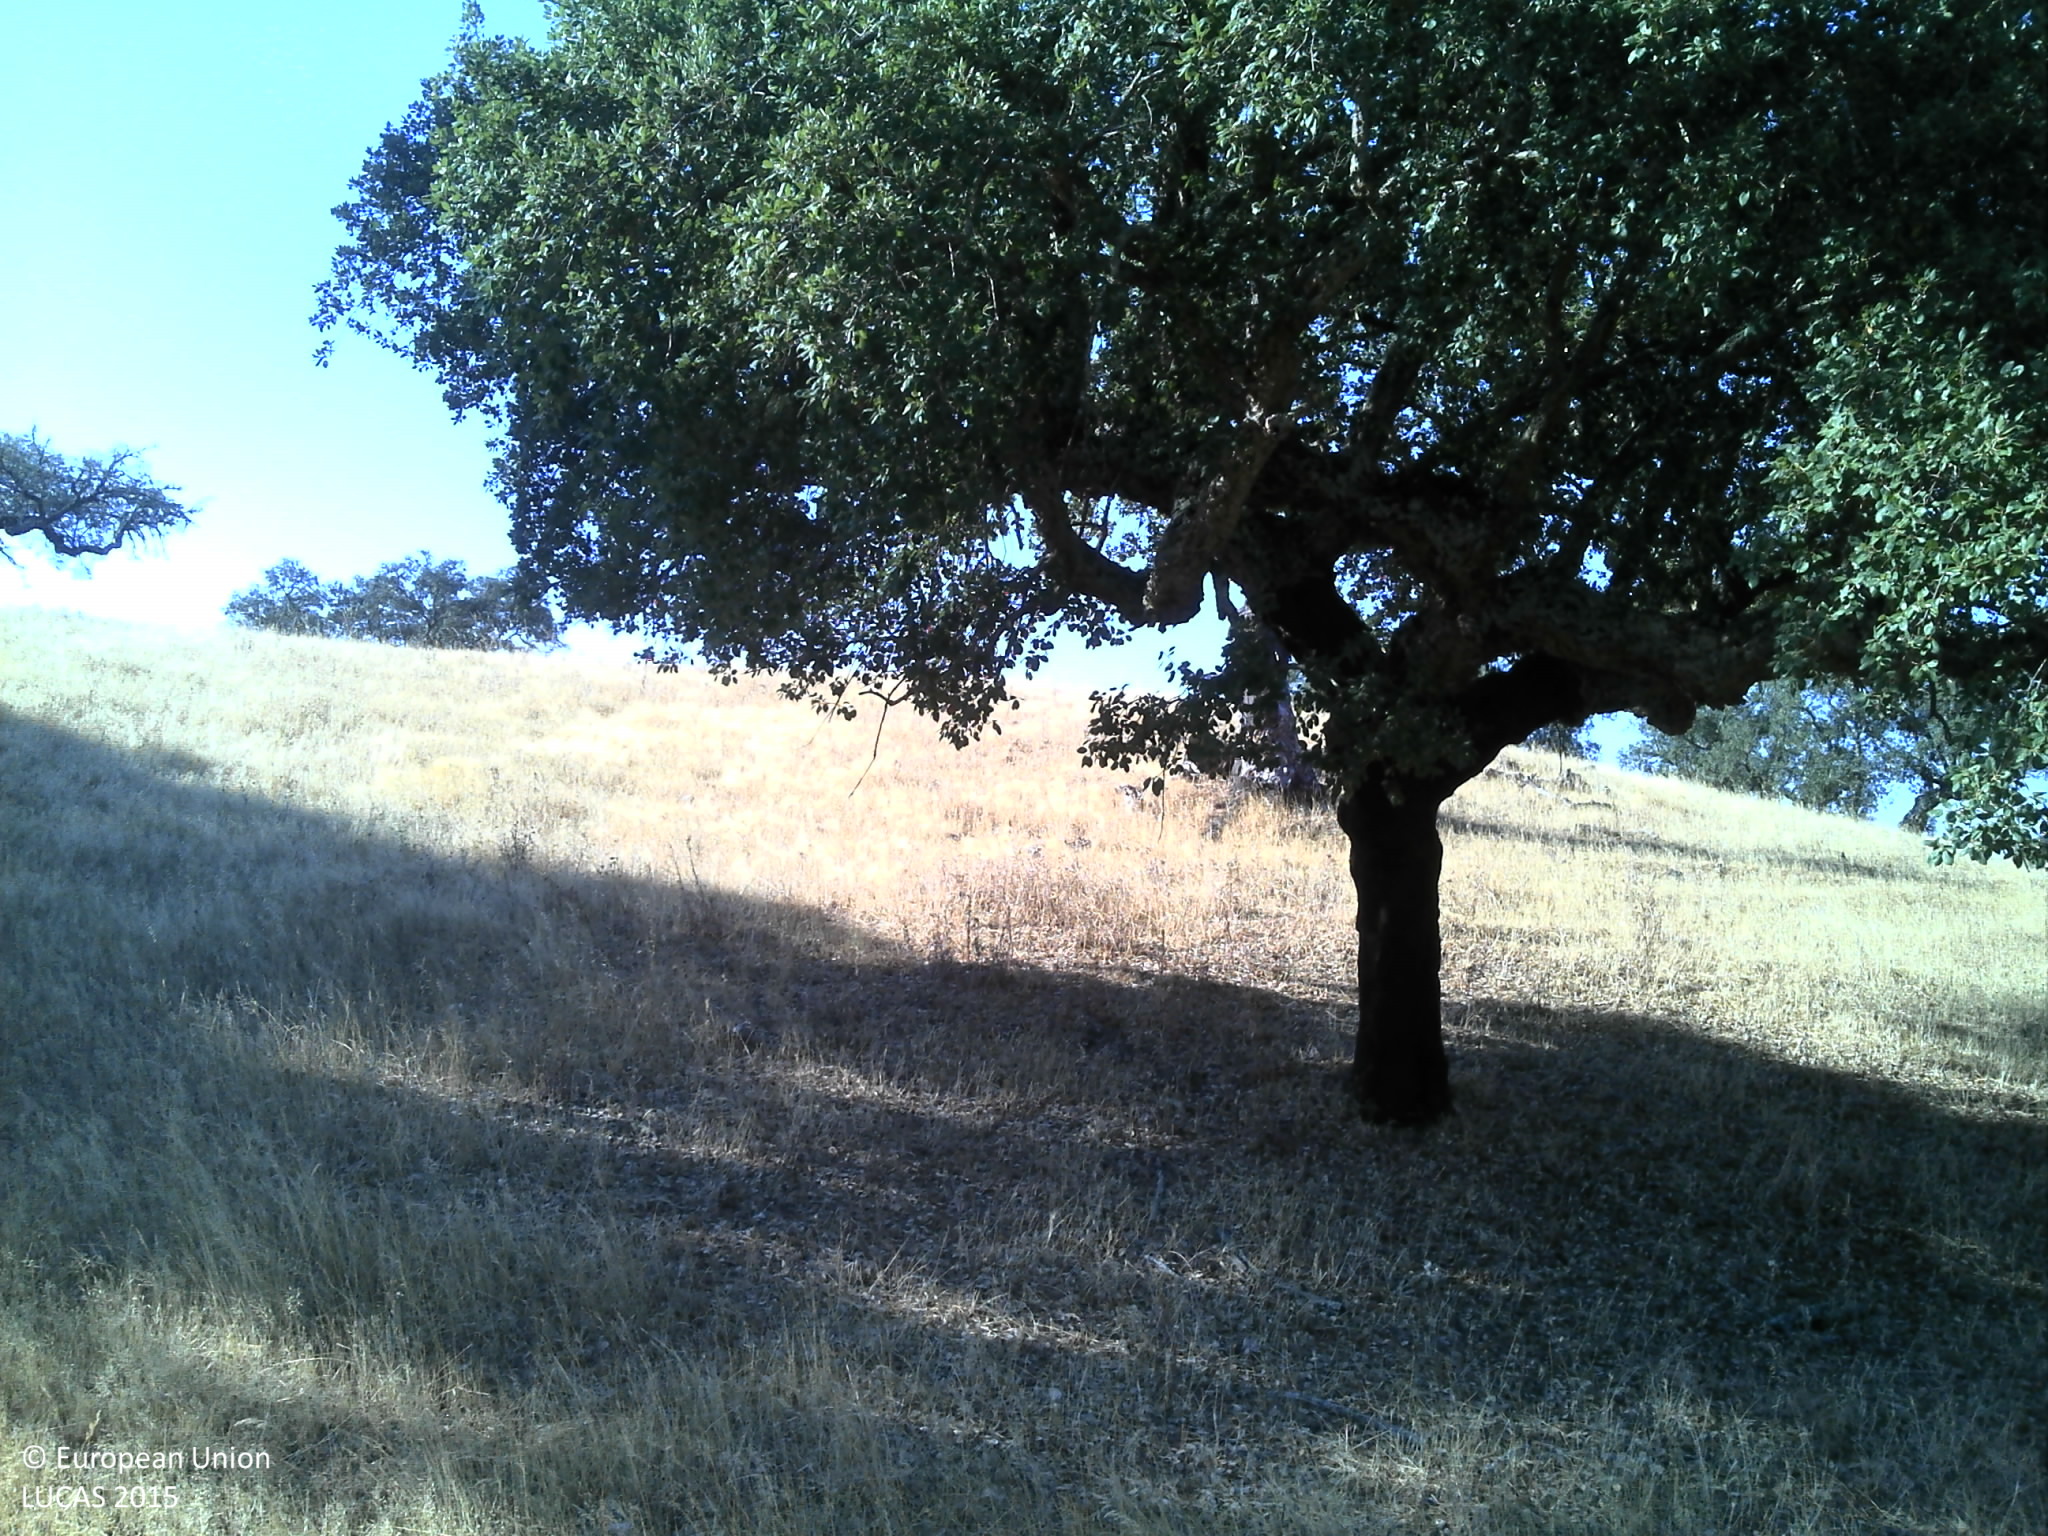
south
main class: Woodland
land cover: Broadleaved woodland
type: broadleaved evergreen forest
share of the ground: 25 - 50 %
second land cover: Grassland without tree/shrub cover
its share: 10 - 25 %
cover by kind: unconsolidated bare surface 50 %, broadleaved forest trees 25 %, herbaceous plants 25 %
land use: Forestry
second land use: Agriculture (excluding fallow land and kitchen gardens)
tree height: > 5 m
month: July
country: PT
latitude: 38.5680
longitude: -7.5098
